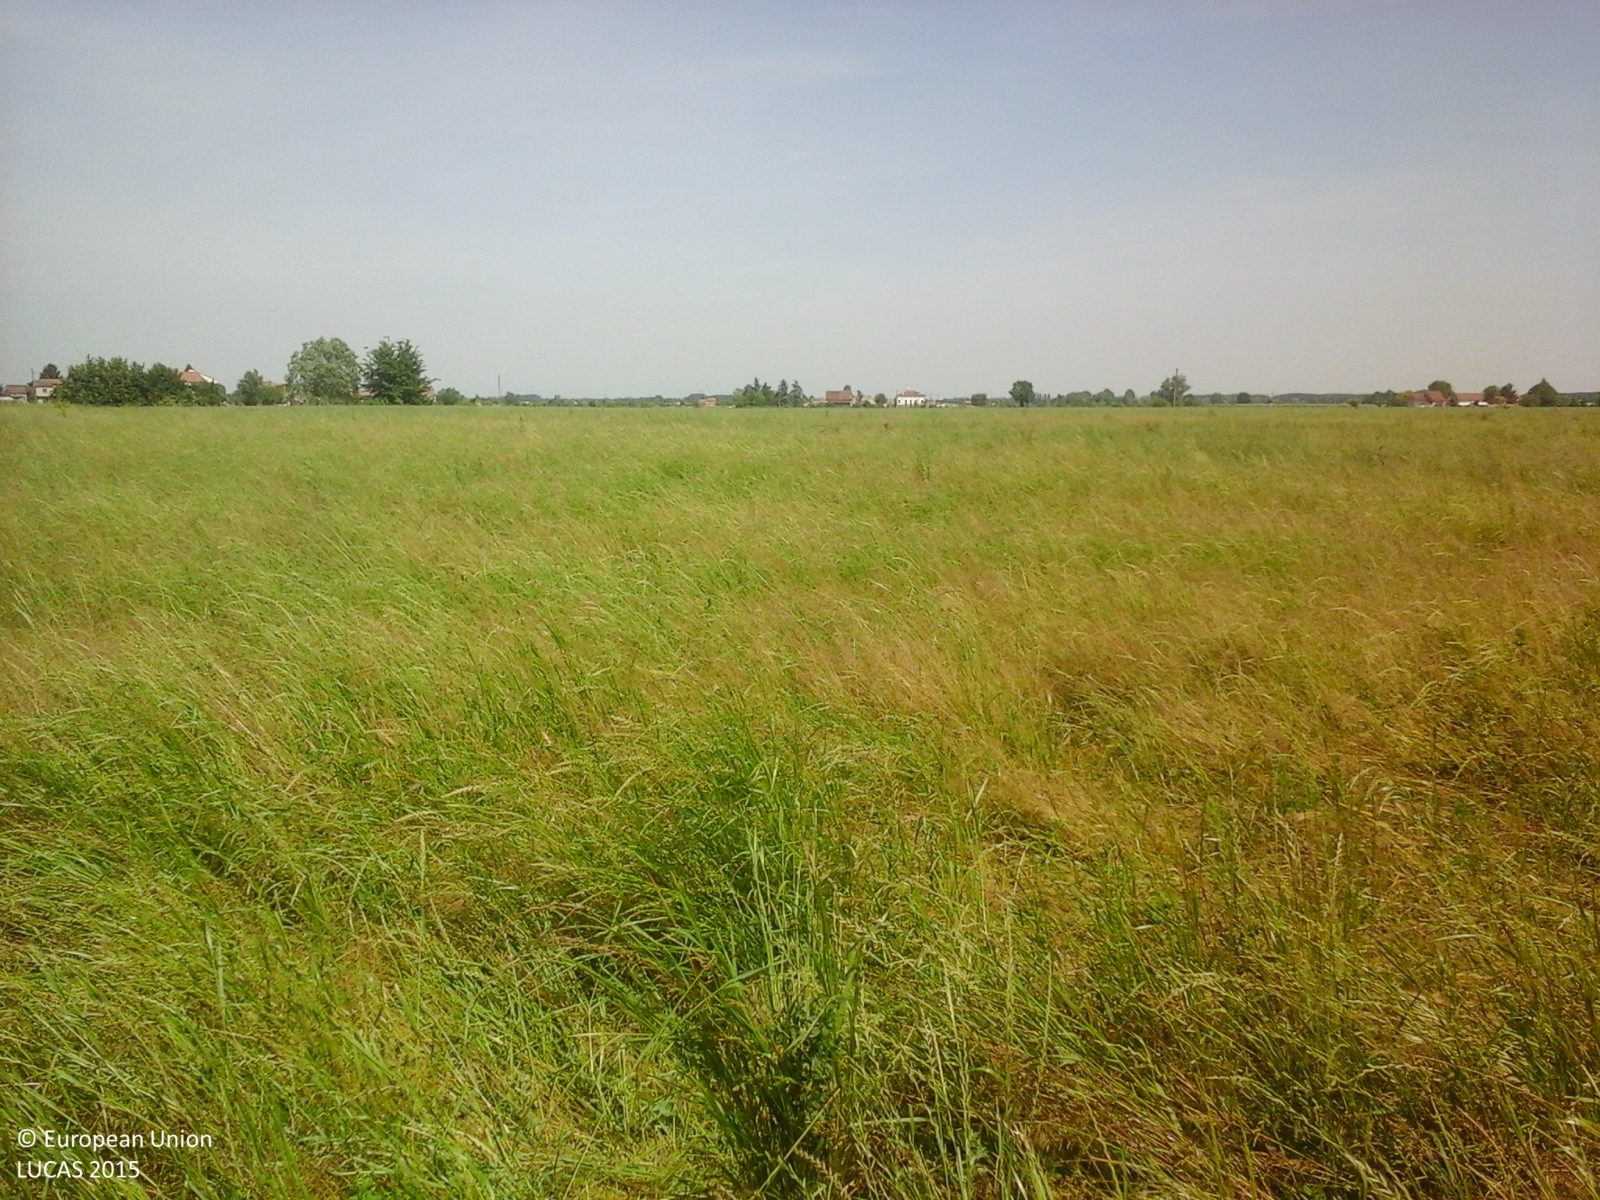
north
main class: Cropland
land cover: Lucerne
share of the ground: > 75 %
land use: Agriculture (excluding fallow land and kitchen gardens)
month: May
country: IT
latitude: 44.9947
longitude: 11.0255
